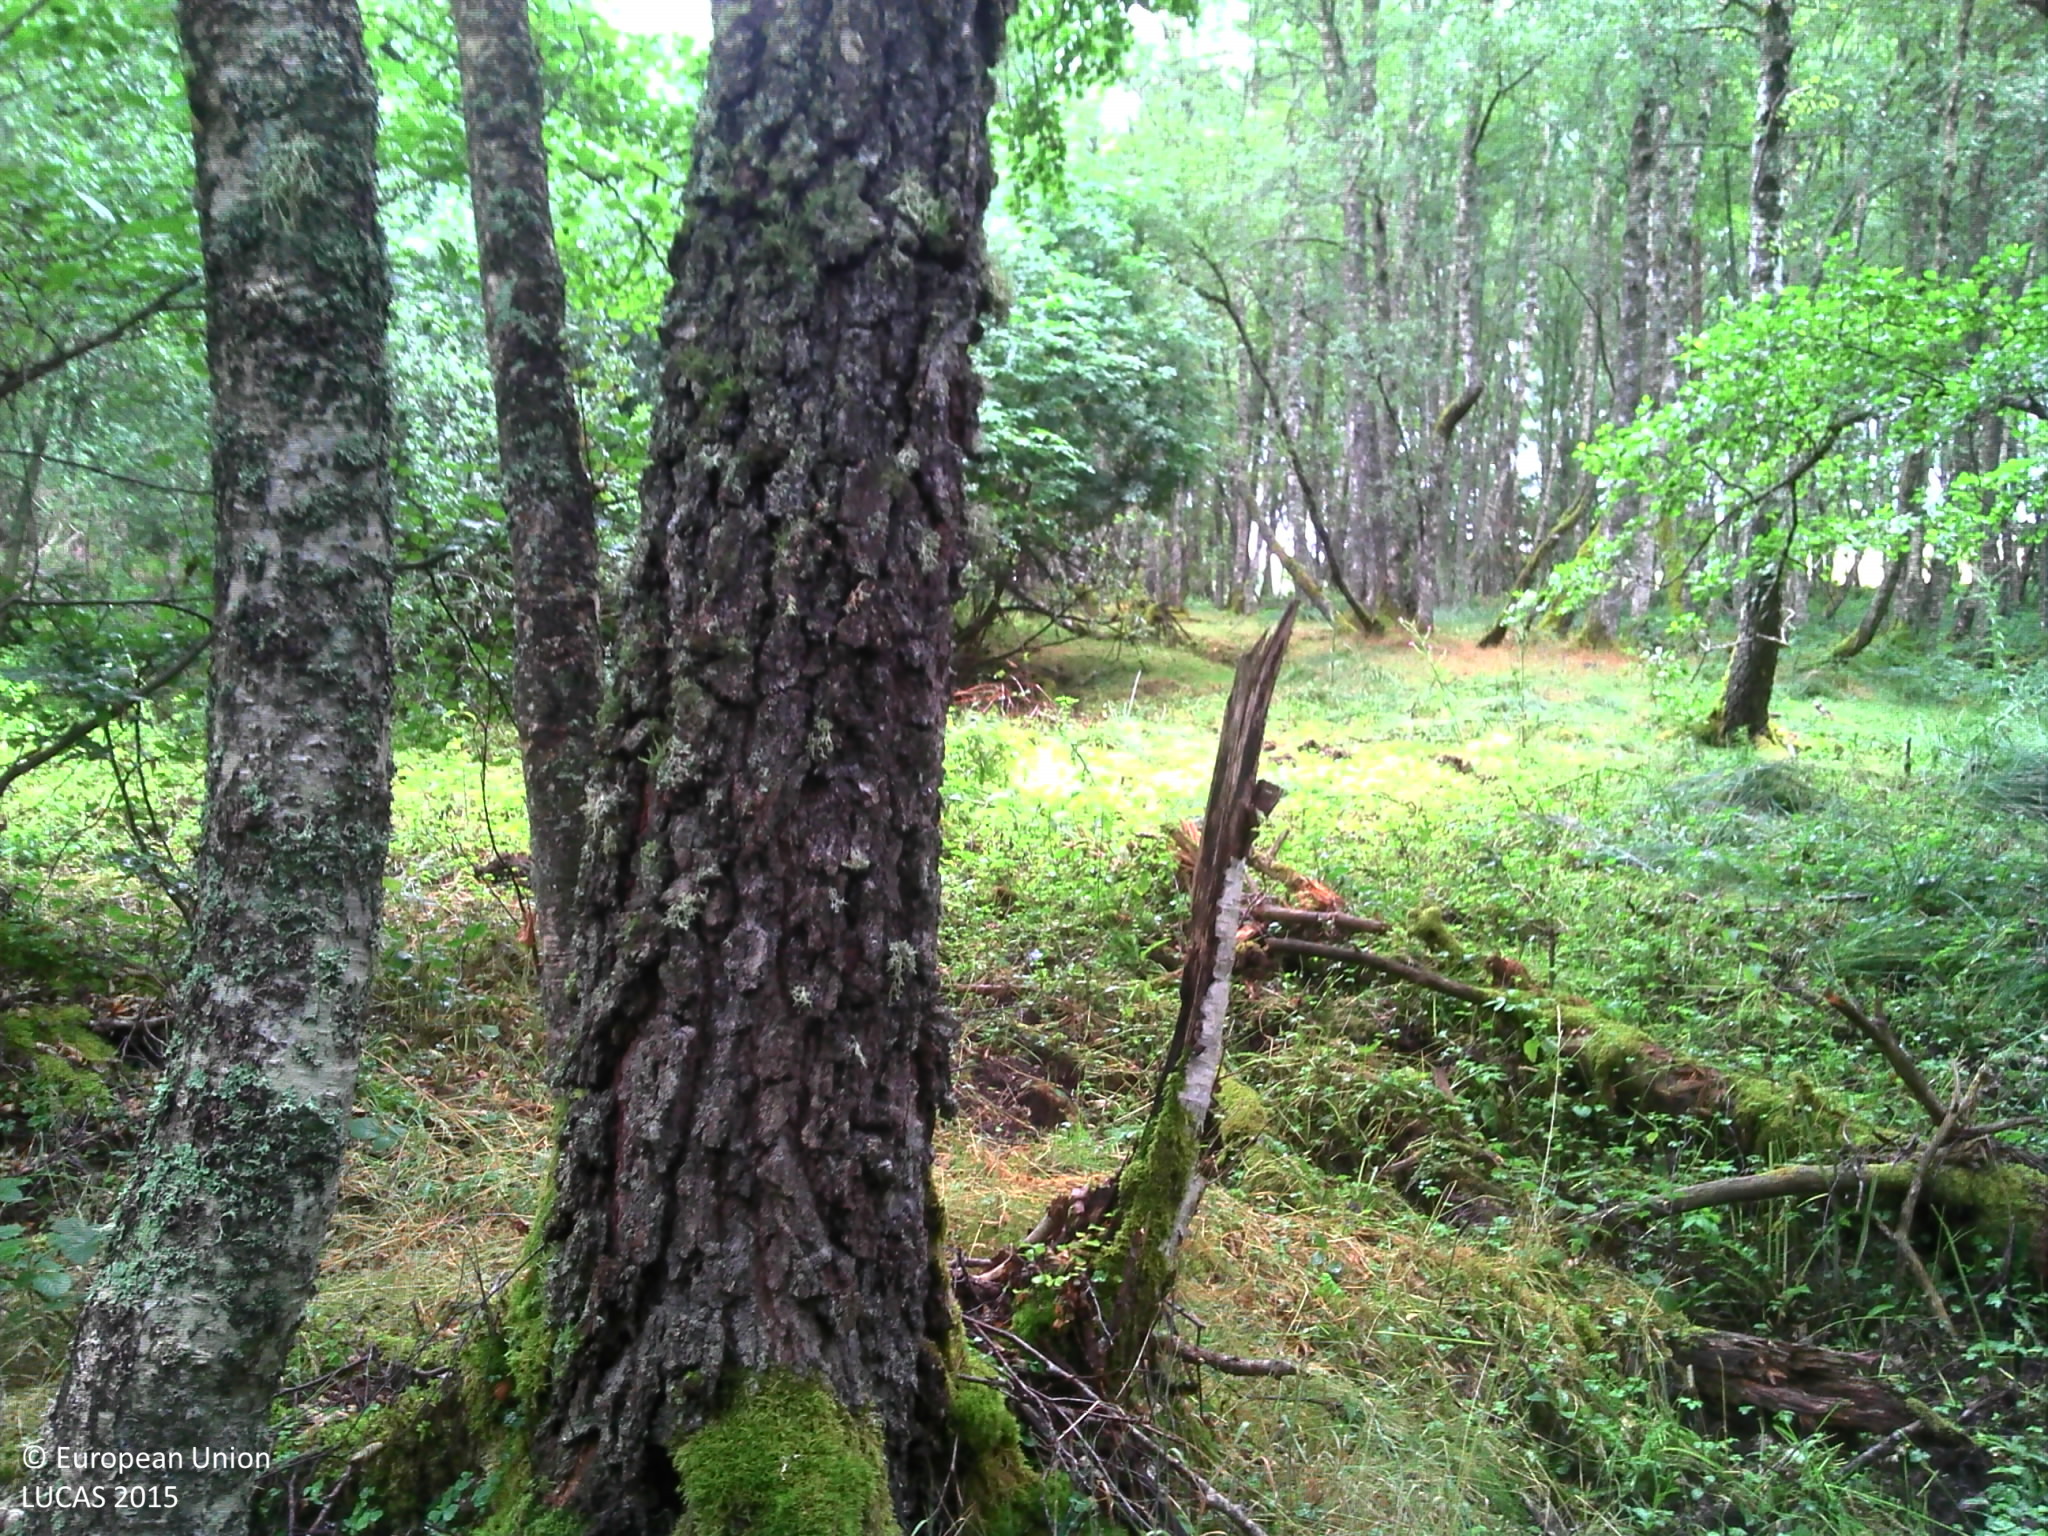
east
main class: Woodland
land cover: Broadleaved woodland
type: non-riverine alder, birch or aspen forest
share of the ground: > 75 %
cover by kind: broadleaved forest trees 80 %, herbaceous plants 20 %
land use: Forestry
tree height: > 5 m
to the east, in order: Broadleaved woodland; Shrubland with sparse tree cover; Broadleaved woodland; Fences; Ditches and canals; Single bushes/trees; Grassland without tree/shrub cover; Fences; Dry stone walls; Lines of trees; Grassland without tree/shrub cover
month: July
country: FR
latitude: 44.8136
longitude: 2.9088
